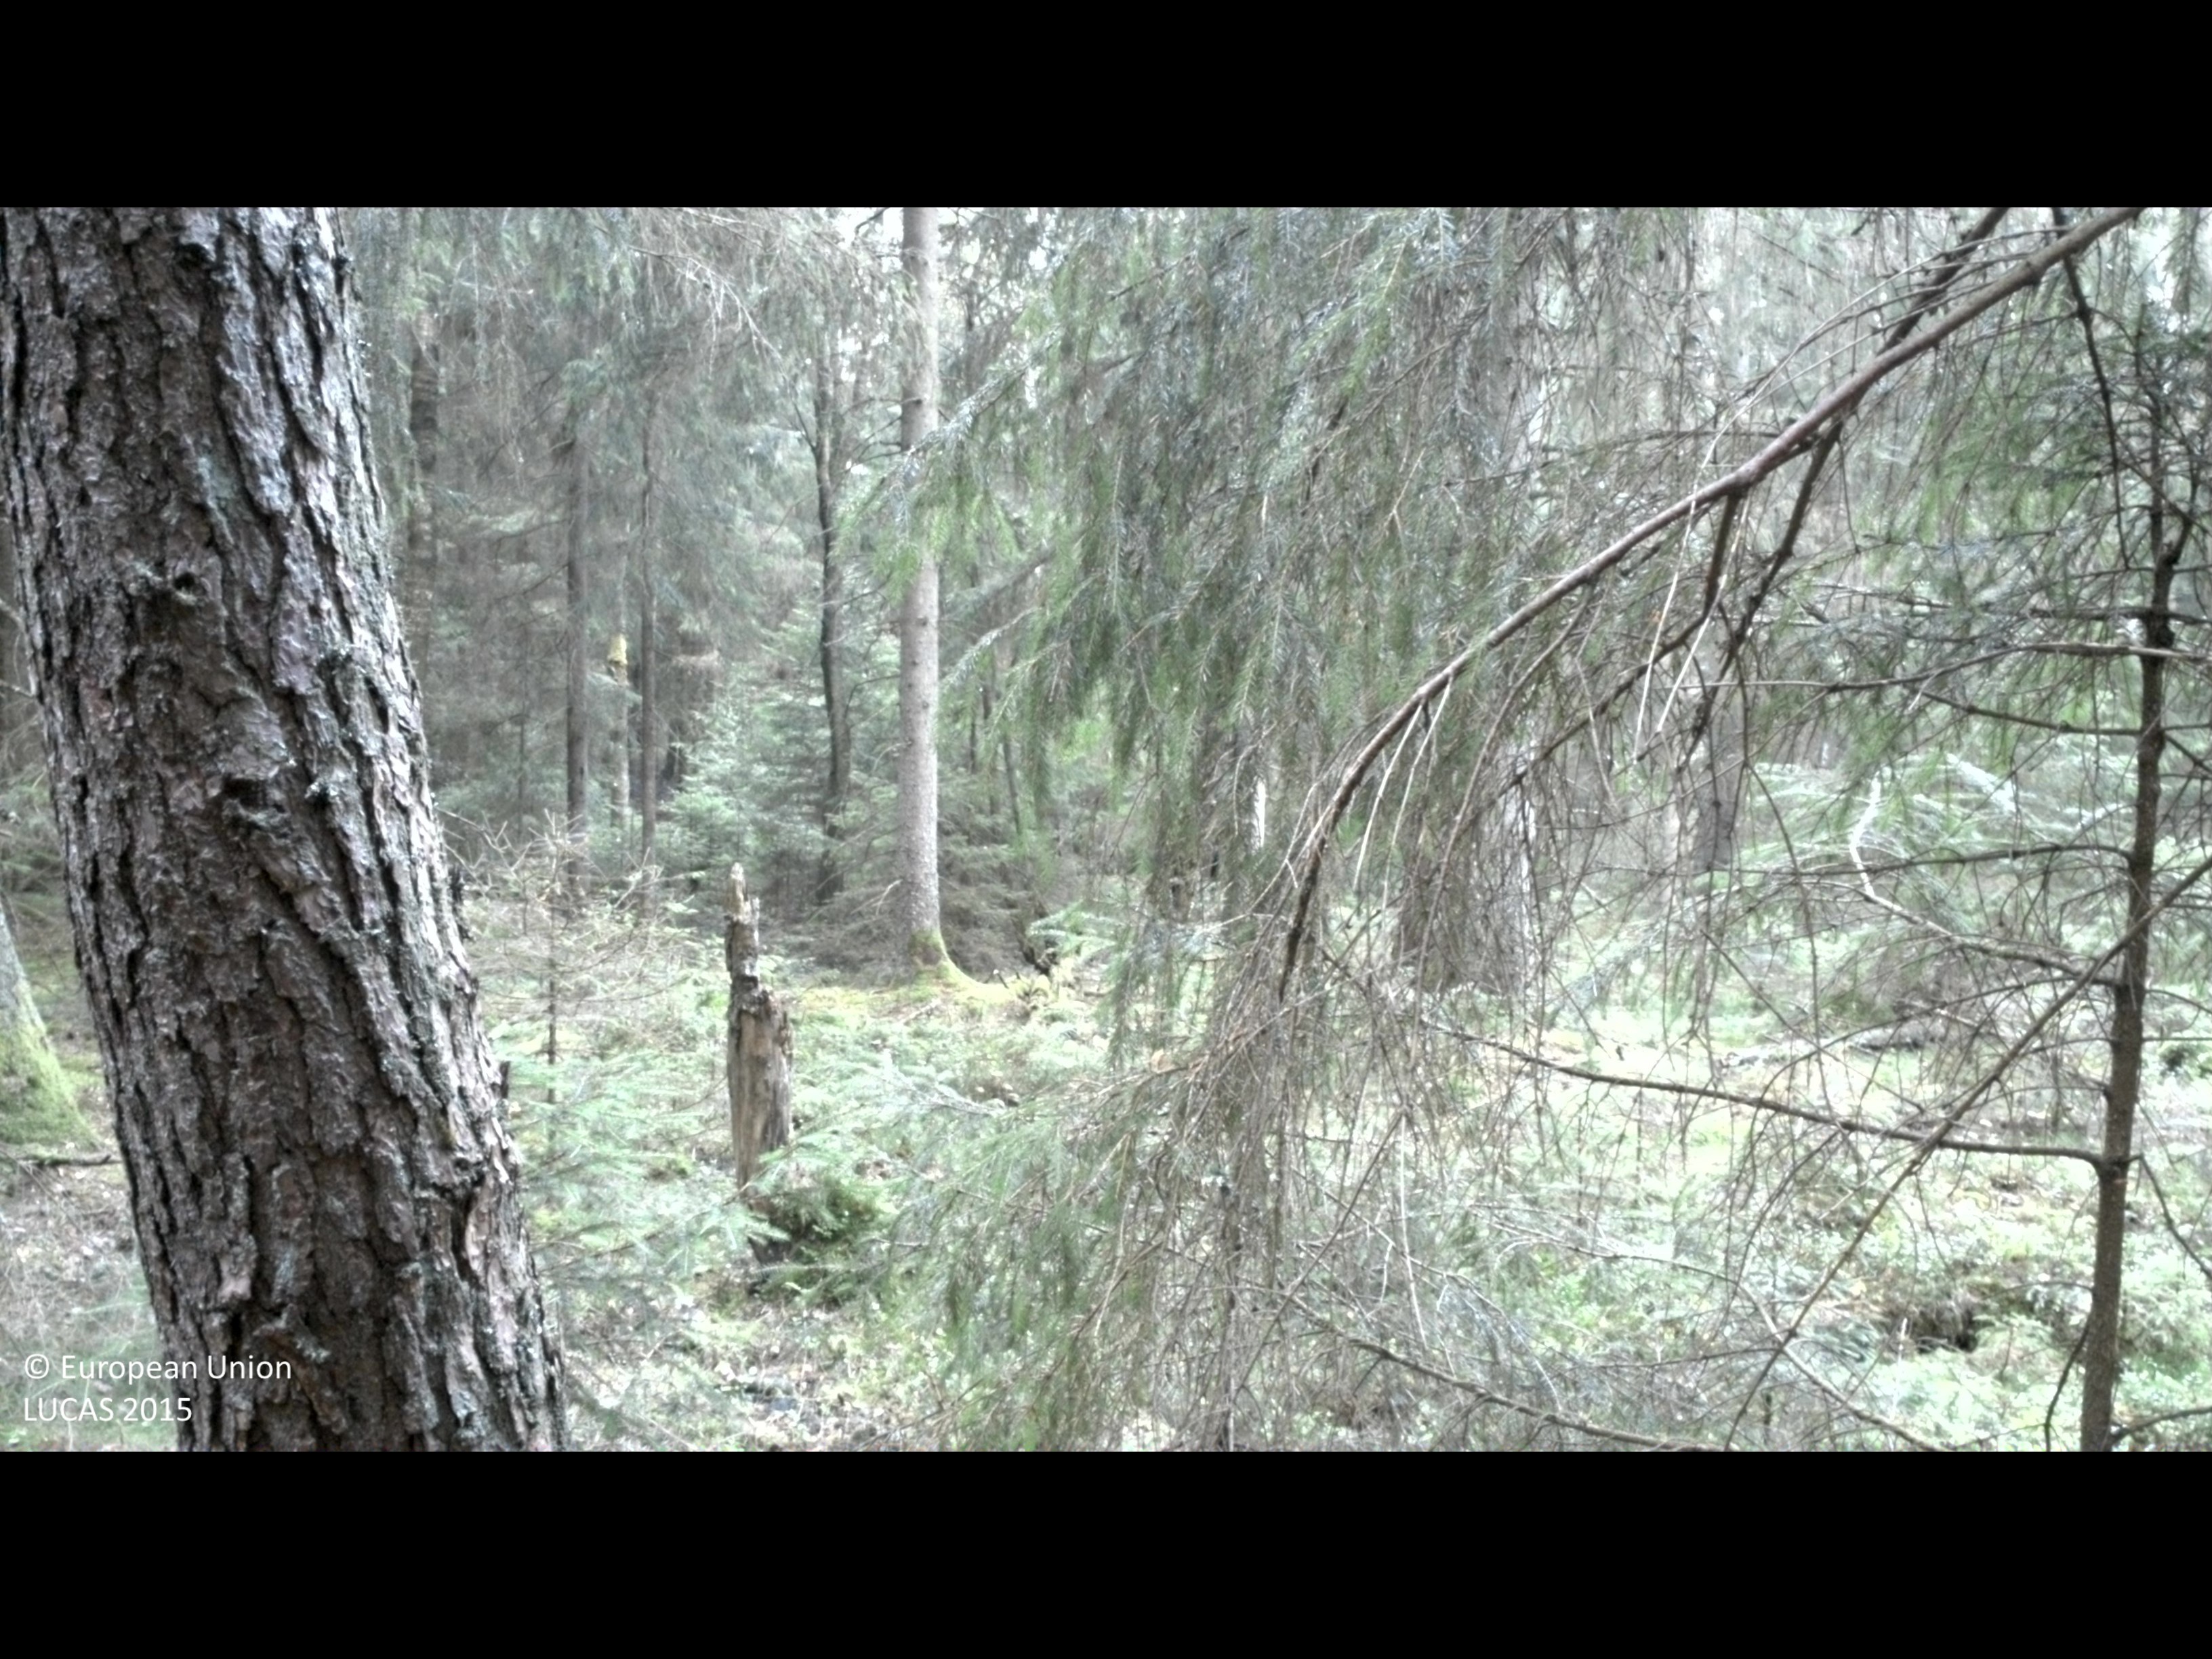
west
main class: Woodland
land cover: Spruce dominated coniferous woodland
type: boreal forest
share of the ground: > 75 %
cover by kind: coniferous forest trees 75 %, shrubs 15 %, broadleaved forest trees 5 %, lichens and mosses 5 %
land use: Forestry
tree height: > 5 m
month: August
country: SE
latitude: 56.9404
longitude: 13.1687
